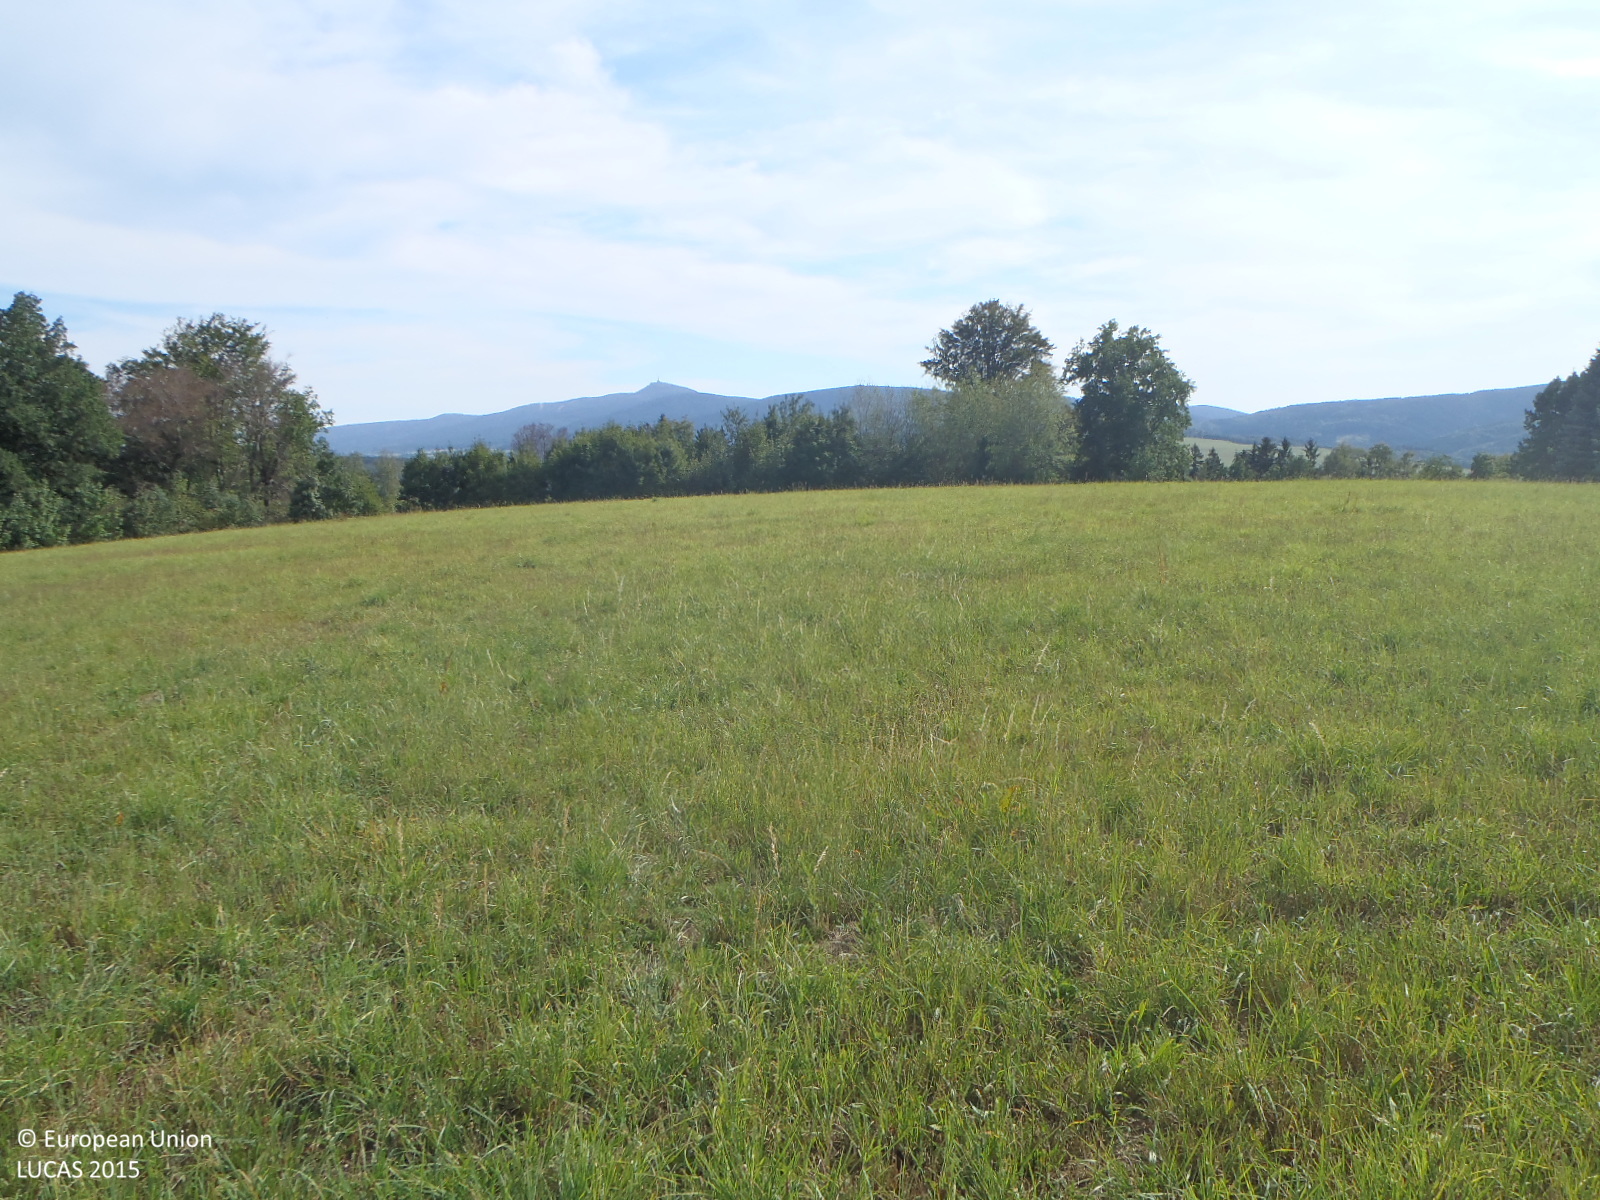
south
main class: Grassland
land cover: Grassland without tree/shrub cover
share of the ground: > 75 %
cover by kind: herbaceous plants 100 %
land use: Agriculture (excluding fallow land and kitchen gardens)
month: August
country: CZ
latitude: 50.8318
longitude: 14.9865
